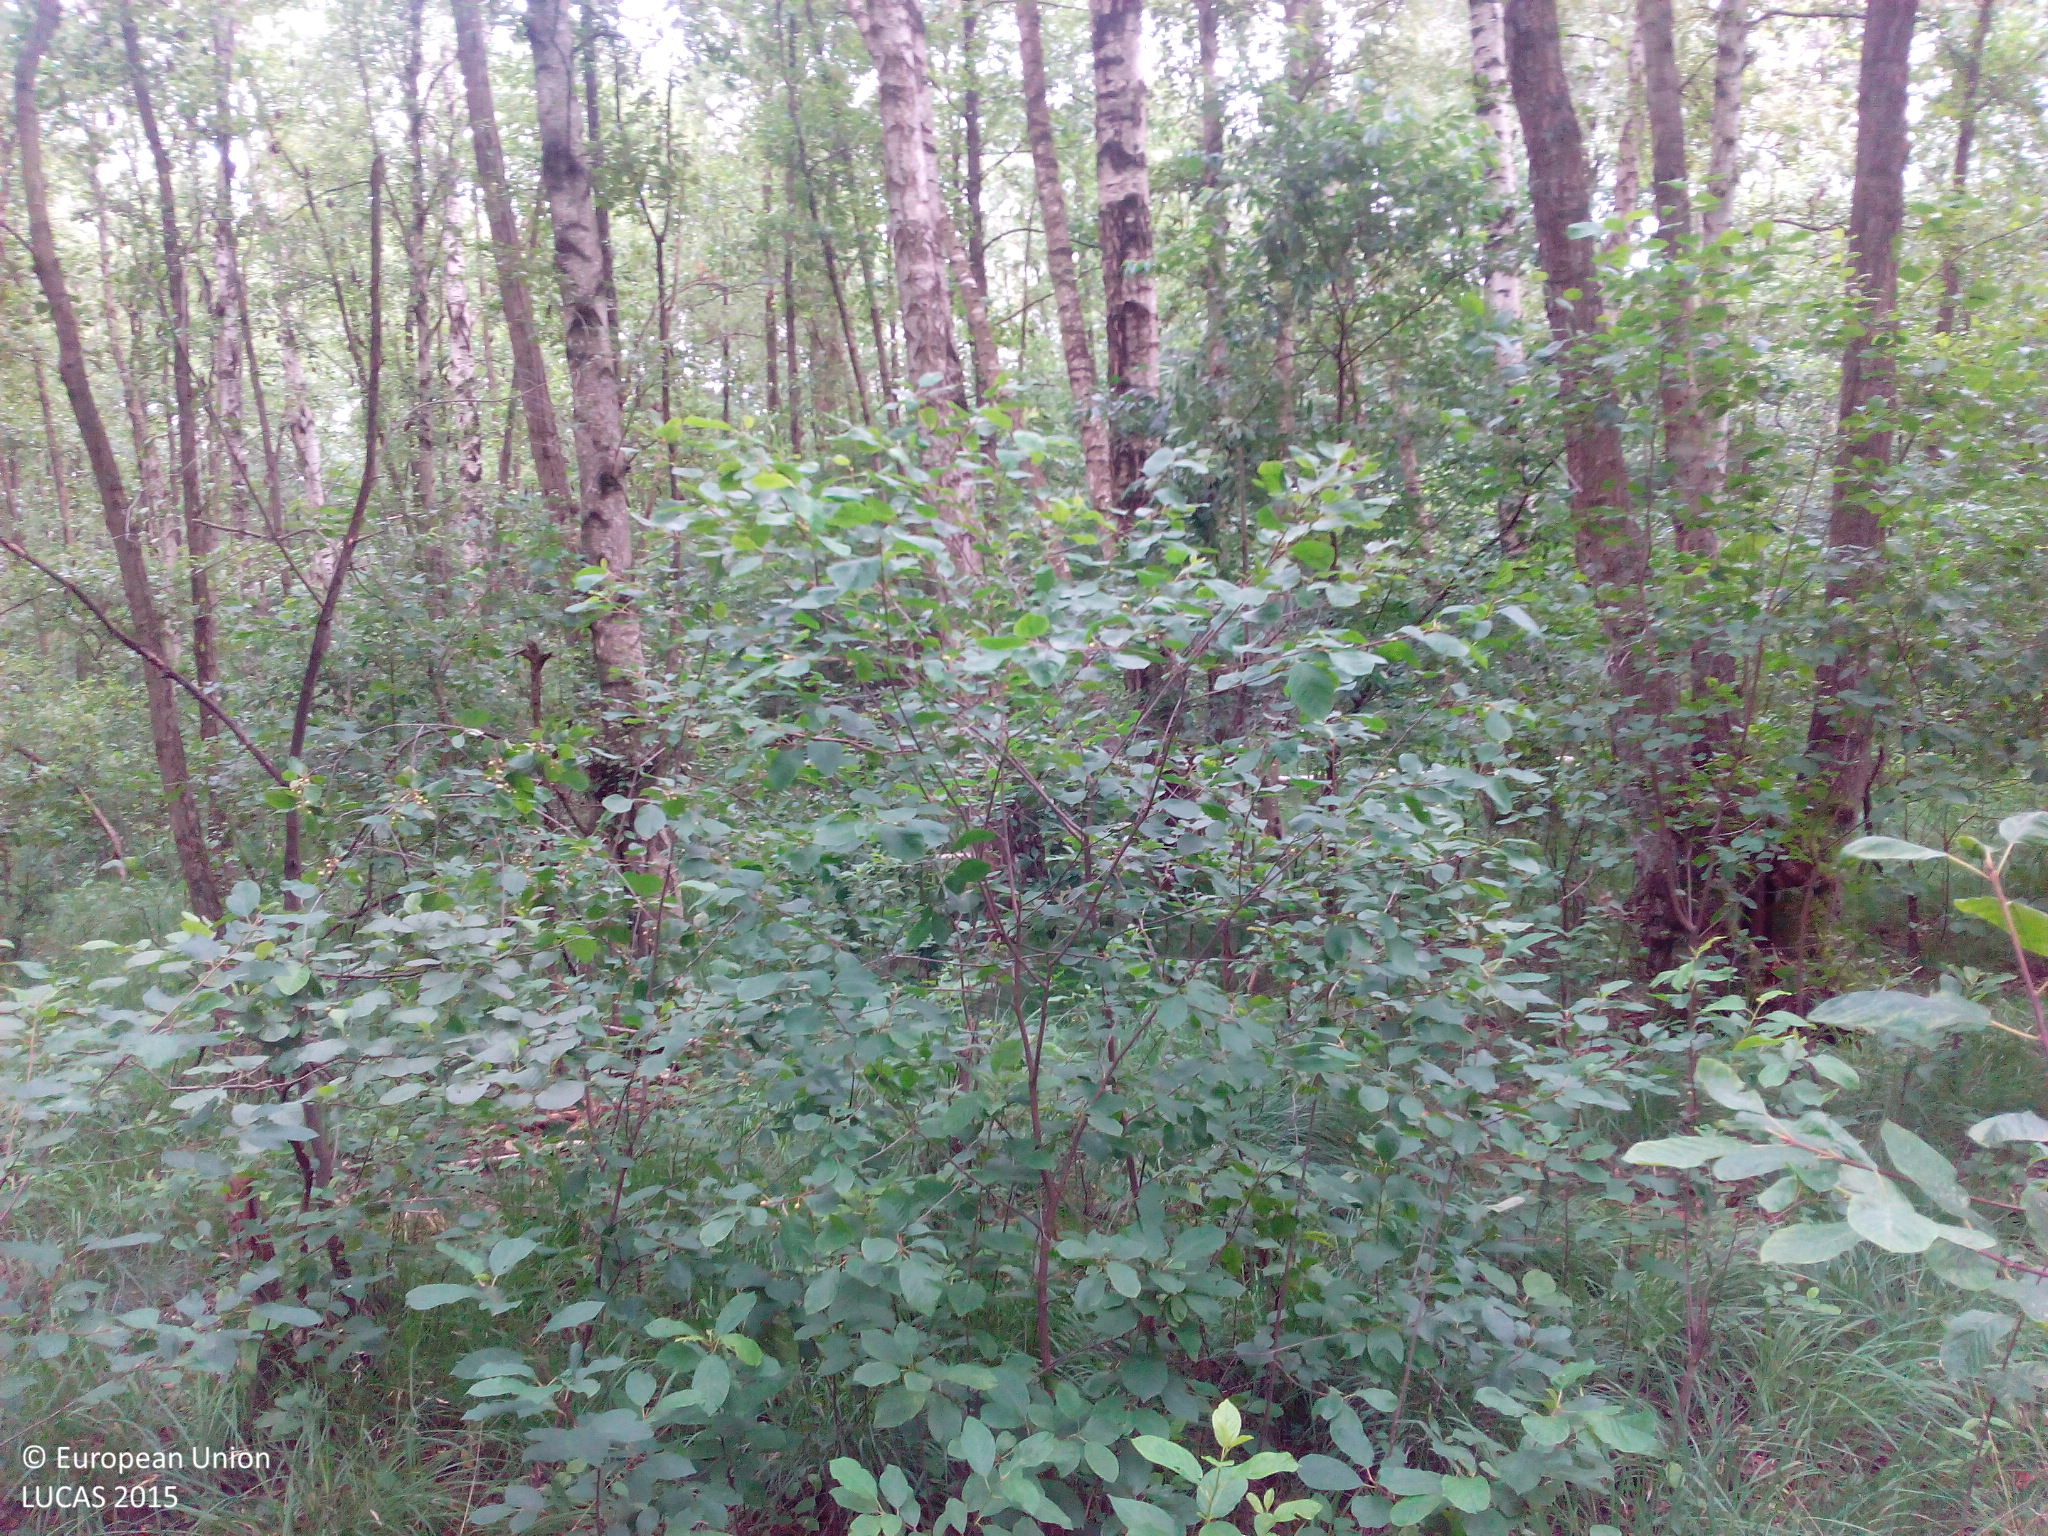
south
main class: Woodland
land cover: Broadleaved woodland
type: mesophytic deciduous forest
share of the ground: > 75 %
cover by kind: broadleaved forest trees 75 %, herbaceous plants 25 %
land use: Forestry
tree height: > 5 m
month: July
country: DE
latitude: 52.1444
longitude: 12.0308
